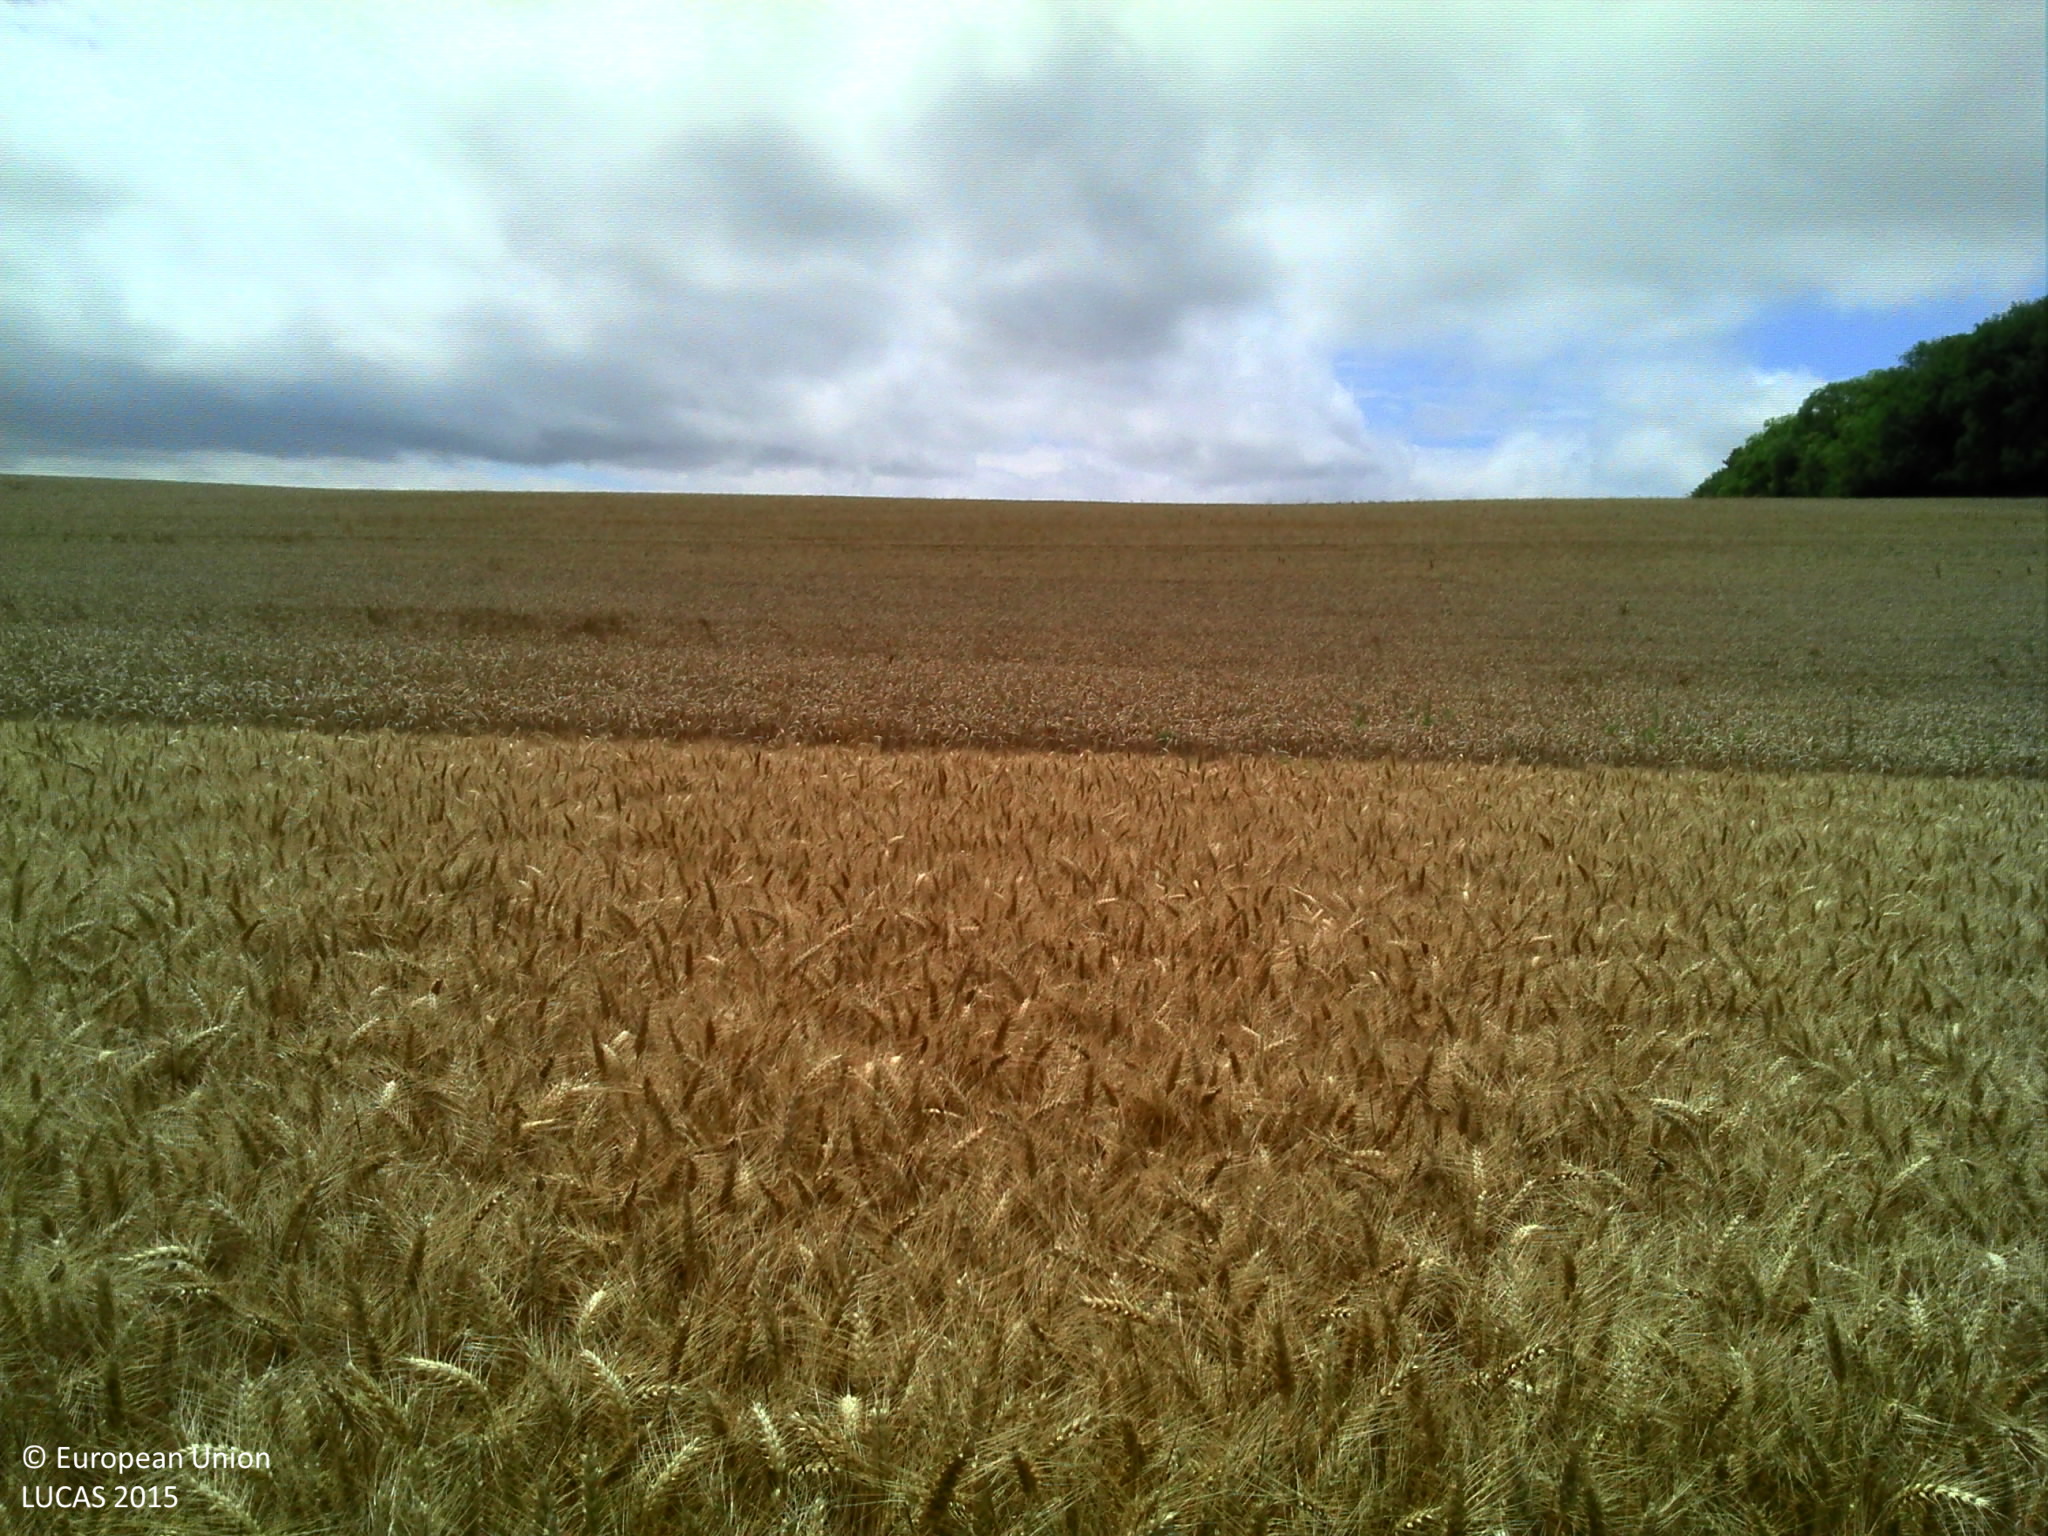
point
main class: Cropland
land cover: Barley
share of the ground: > 75 %
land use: Agriculture (excluding fallow land and kitchen gardens)
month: July
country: FR
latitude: 49.9883
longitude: 2.1890
